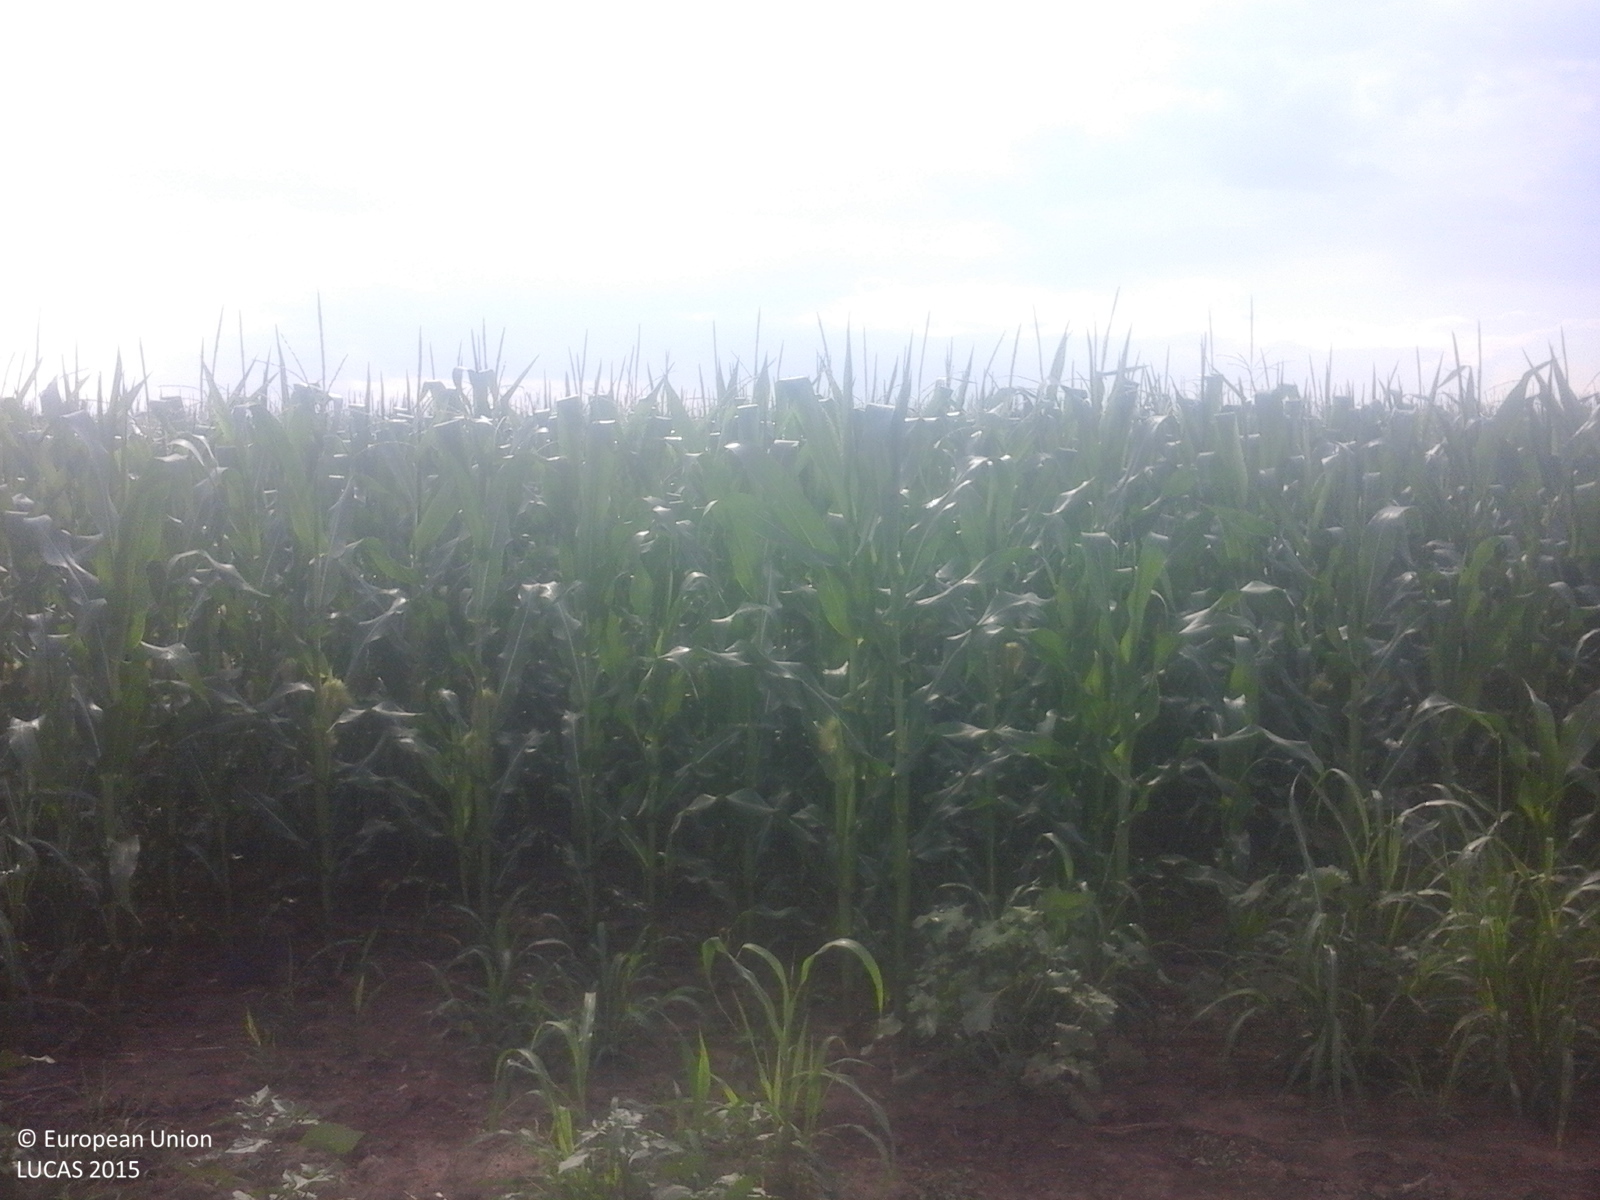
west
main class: Cropland
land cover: Maize
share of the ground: > 75 %
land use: Agriculture (excluding fallow land and kitchen gardens)
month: July
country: RO
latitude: 43.7355
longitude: 24.7061
